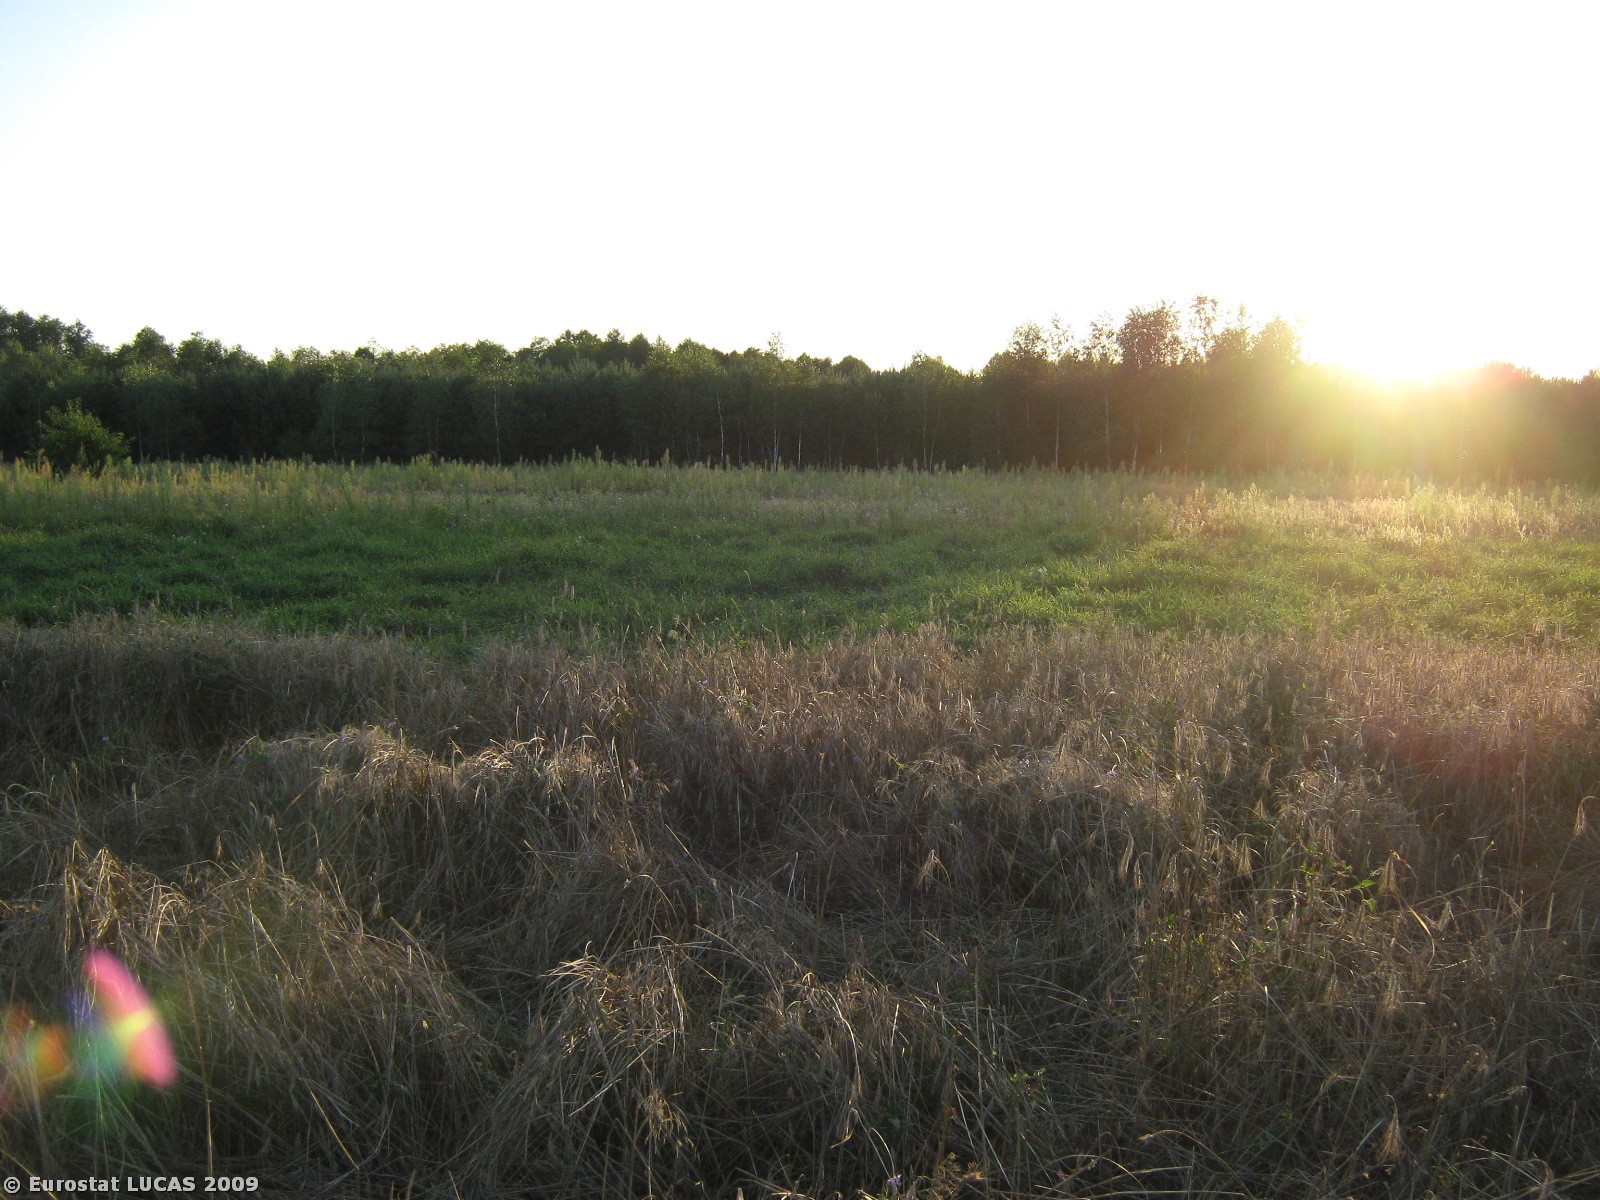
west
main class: Cropland
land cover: Rye
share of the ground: > 75 %
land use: Agriculture (excluding fallow land and kitchen gardens)
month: August
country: PL
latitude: 52.3710
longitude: 19.5605
